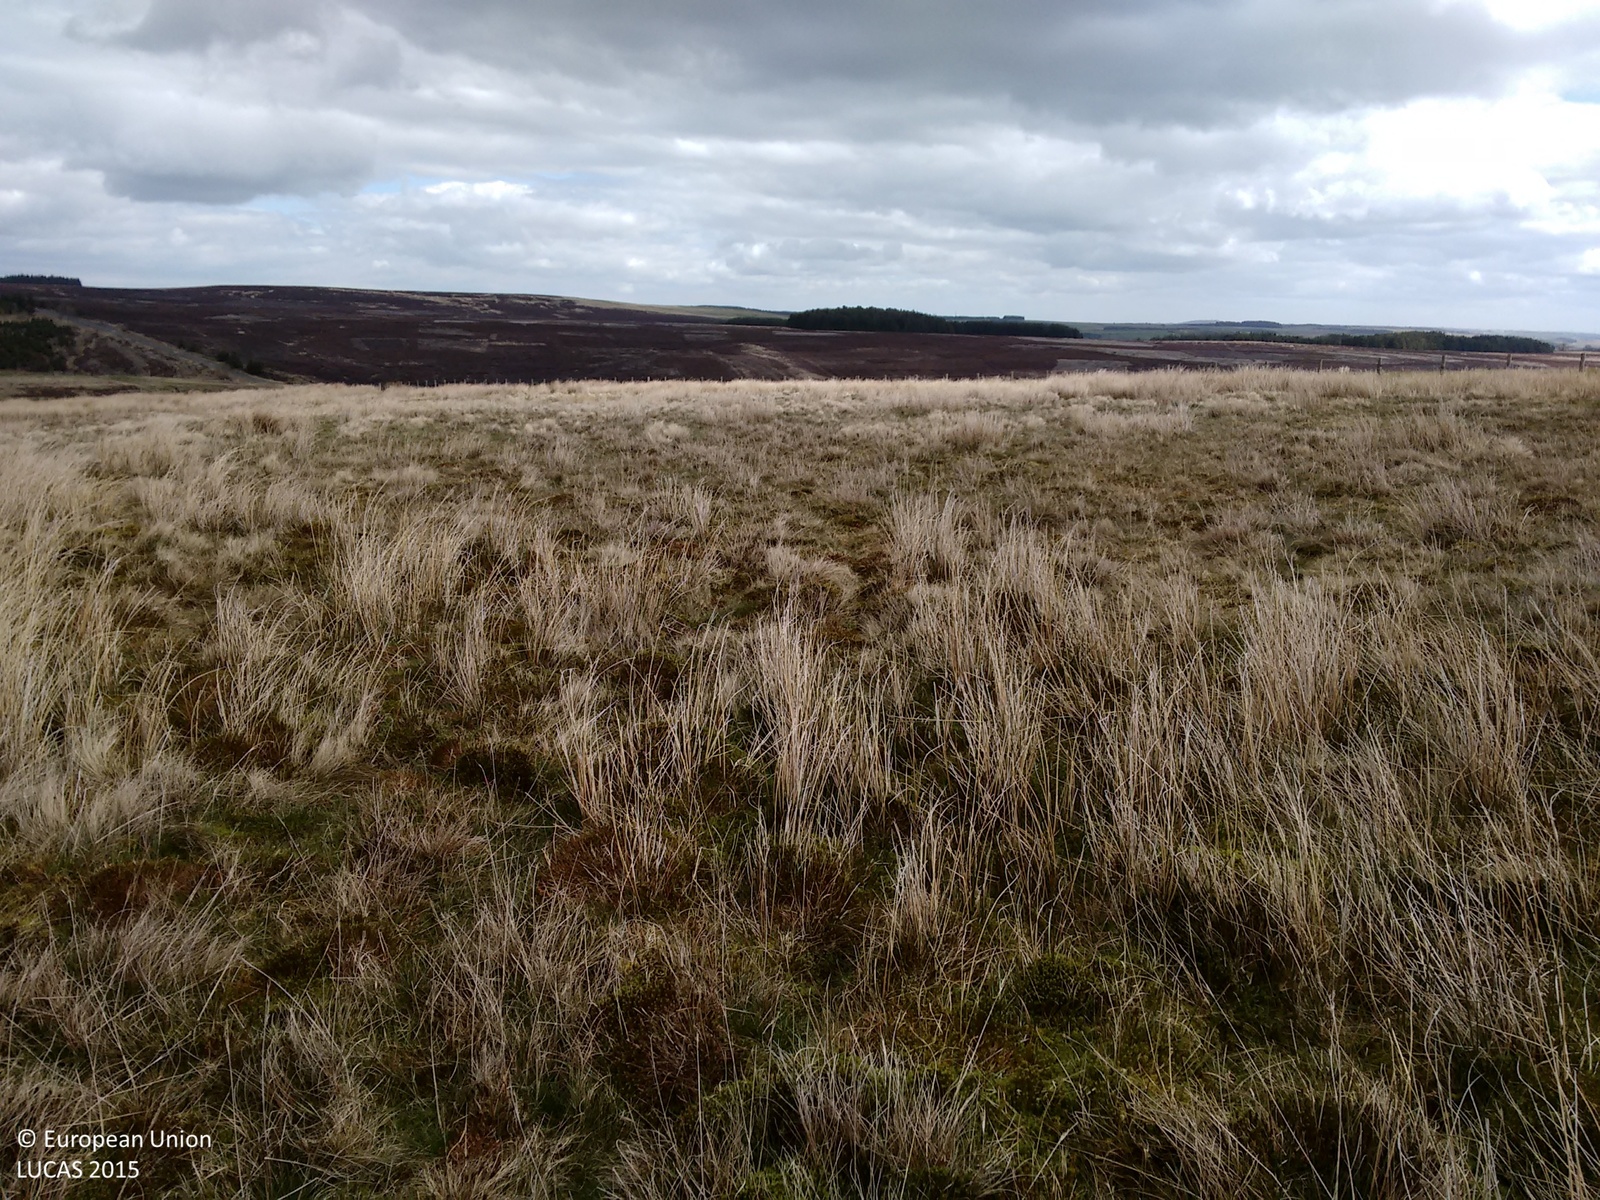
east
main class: Grassland
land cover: Grassland without tree/shrub cover
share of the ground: > 75 %
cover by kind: herbaceous plants 100 %
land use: Agriculture (excluding fallow land and kitchen gardens)
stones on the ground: < 10 %
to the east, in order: Grassland without tree/shrub cover; Shrubland without tree cover; Fences; Grassland without tree/shrub cover
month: May
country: GB
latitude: 54.8723
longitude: -2.0392
